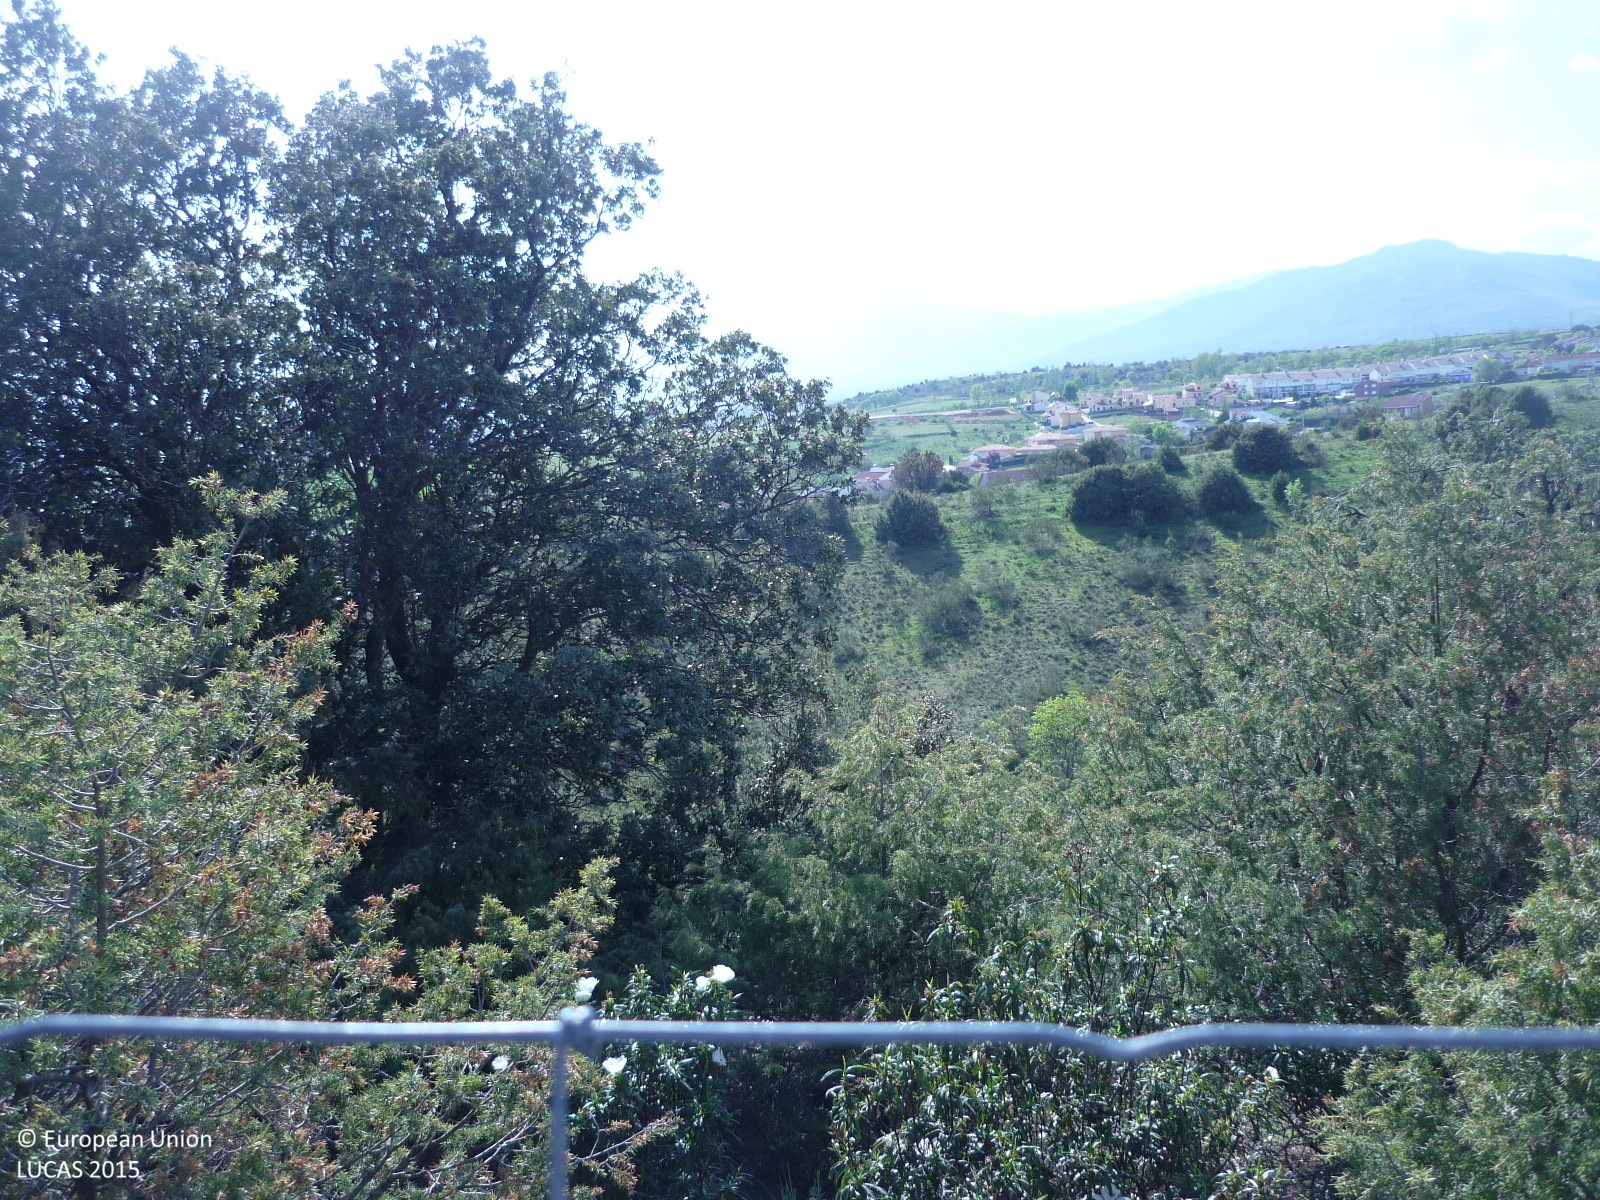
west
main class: Woodland
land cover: Other coniferous woodland
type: coniferous forest of the mediterranean region
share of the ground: 25 - 50 %
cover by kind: coniferous forest trees 40 %, shrubs 20 %, herbaceous plants 20 %, unconsolidated bare surface 20 %
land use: Semi-natural and natural areas not in use
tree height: < 5 m
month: April
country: ES
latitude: 40.8149
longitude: -3.6158
